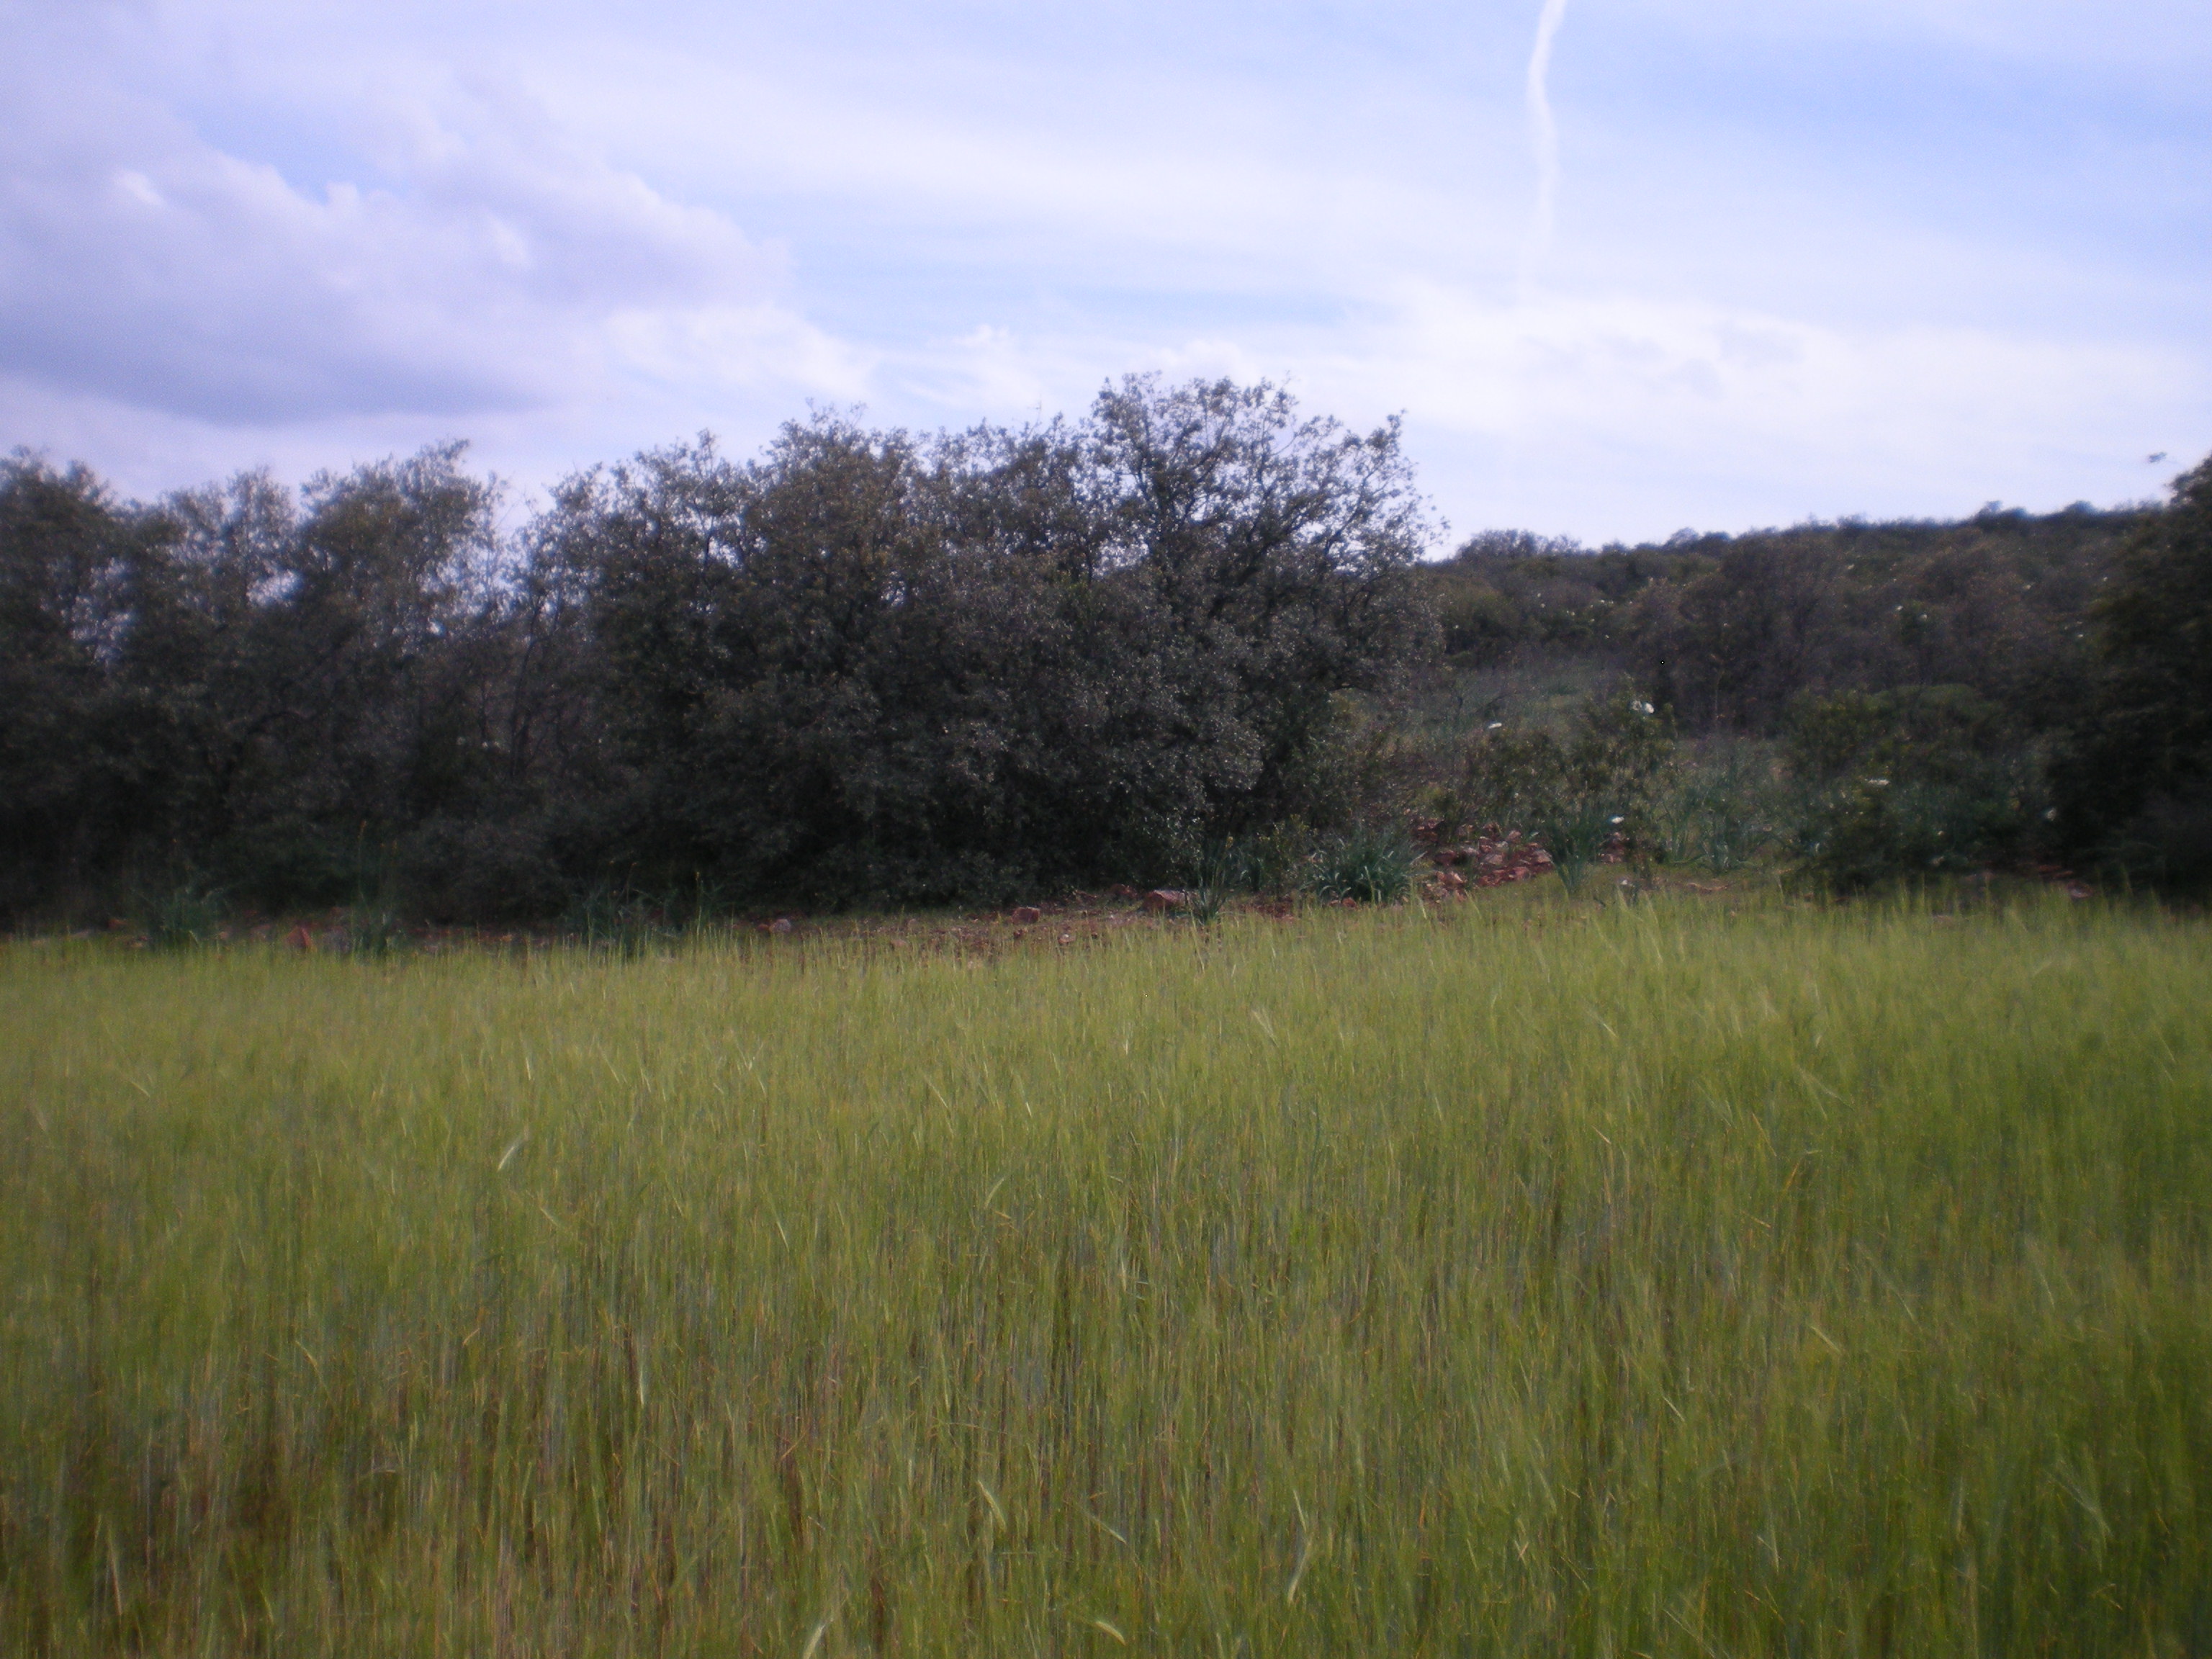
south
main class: Cropland
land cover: Barley
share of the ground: > 75 %
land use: Agriculture (excluding fallow land and kitchen gardens)
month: April
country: ES
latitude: 38.9056
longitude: -3.5178
